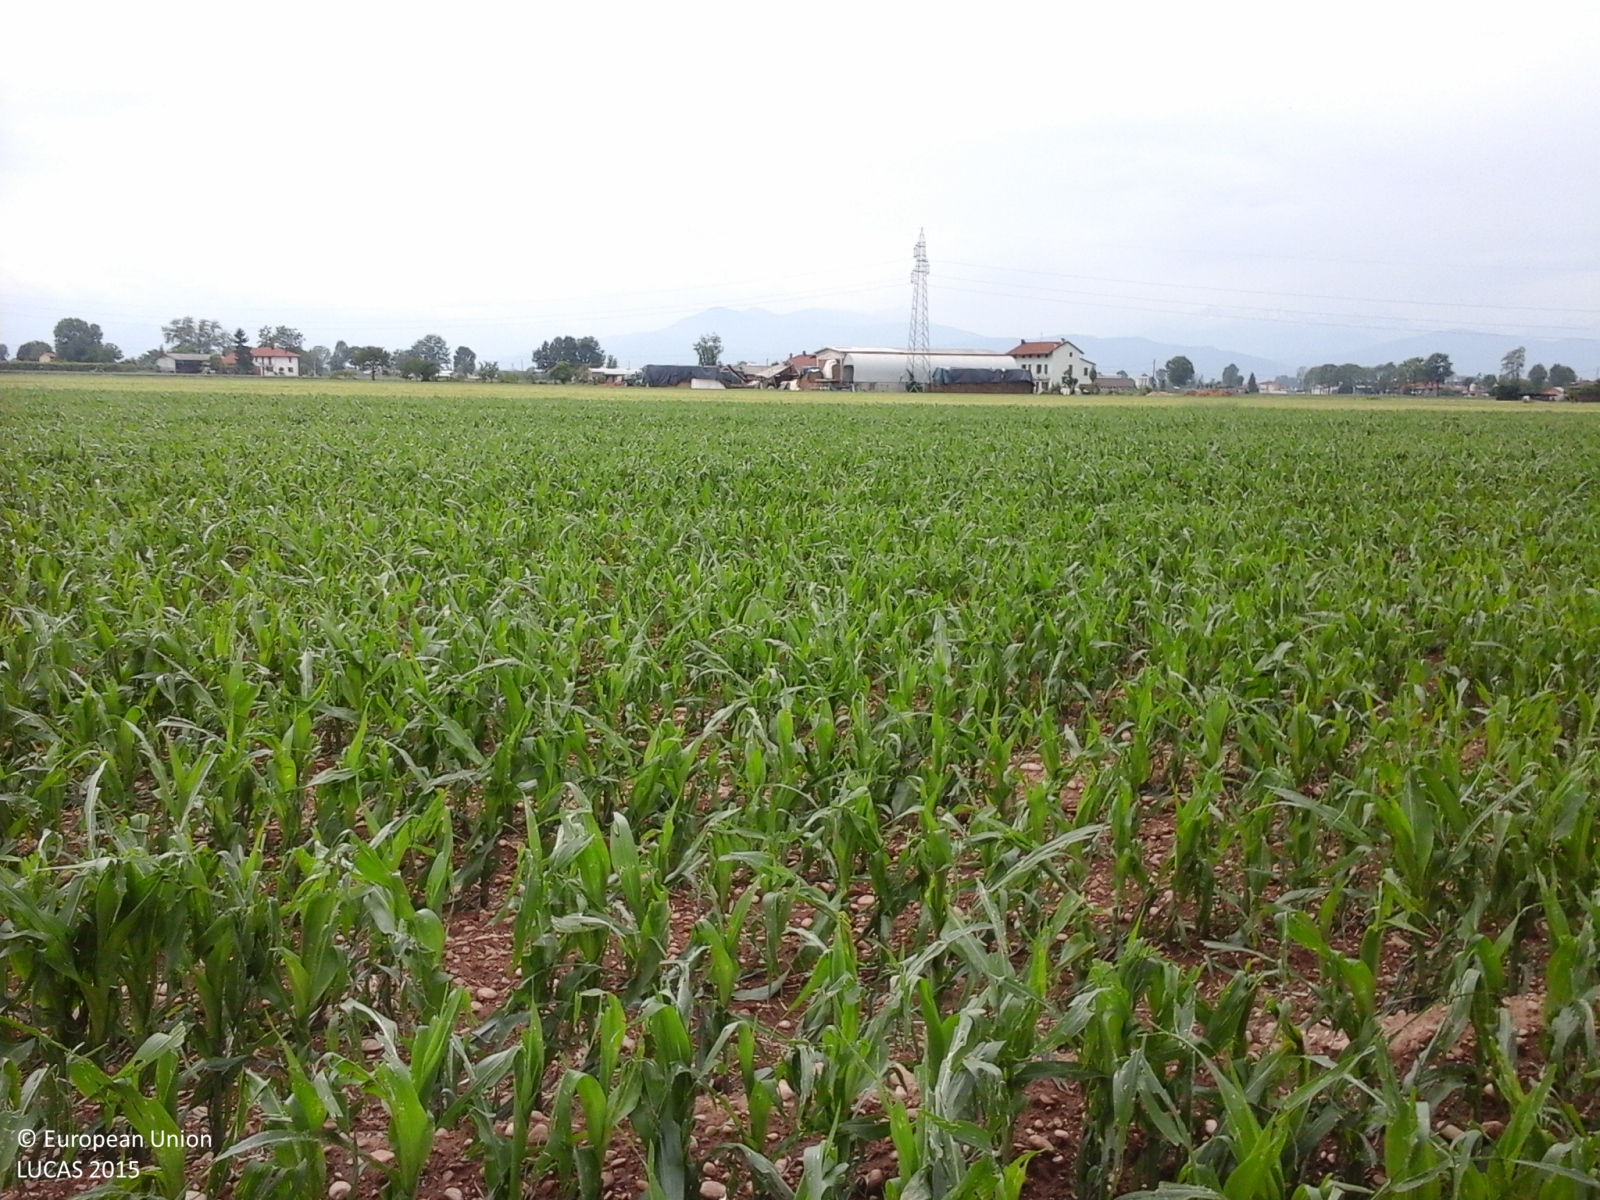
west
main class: Cropland
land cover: Maize
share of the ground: 25 - 50 %
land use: Agriculture (excluding fallow land and kitchen gardens)
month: May
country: IT
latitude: 44.5044
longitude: 7.6527
